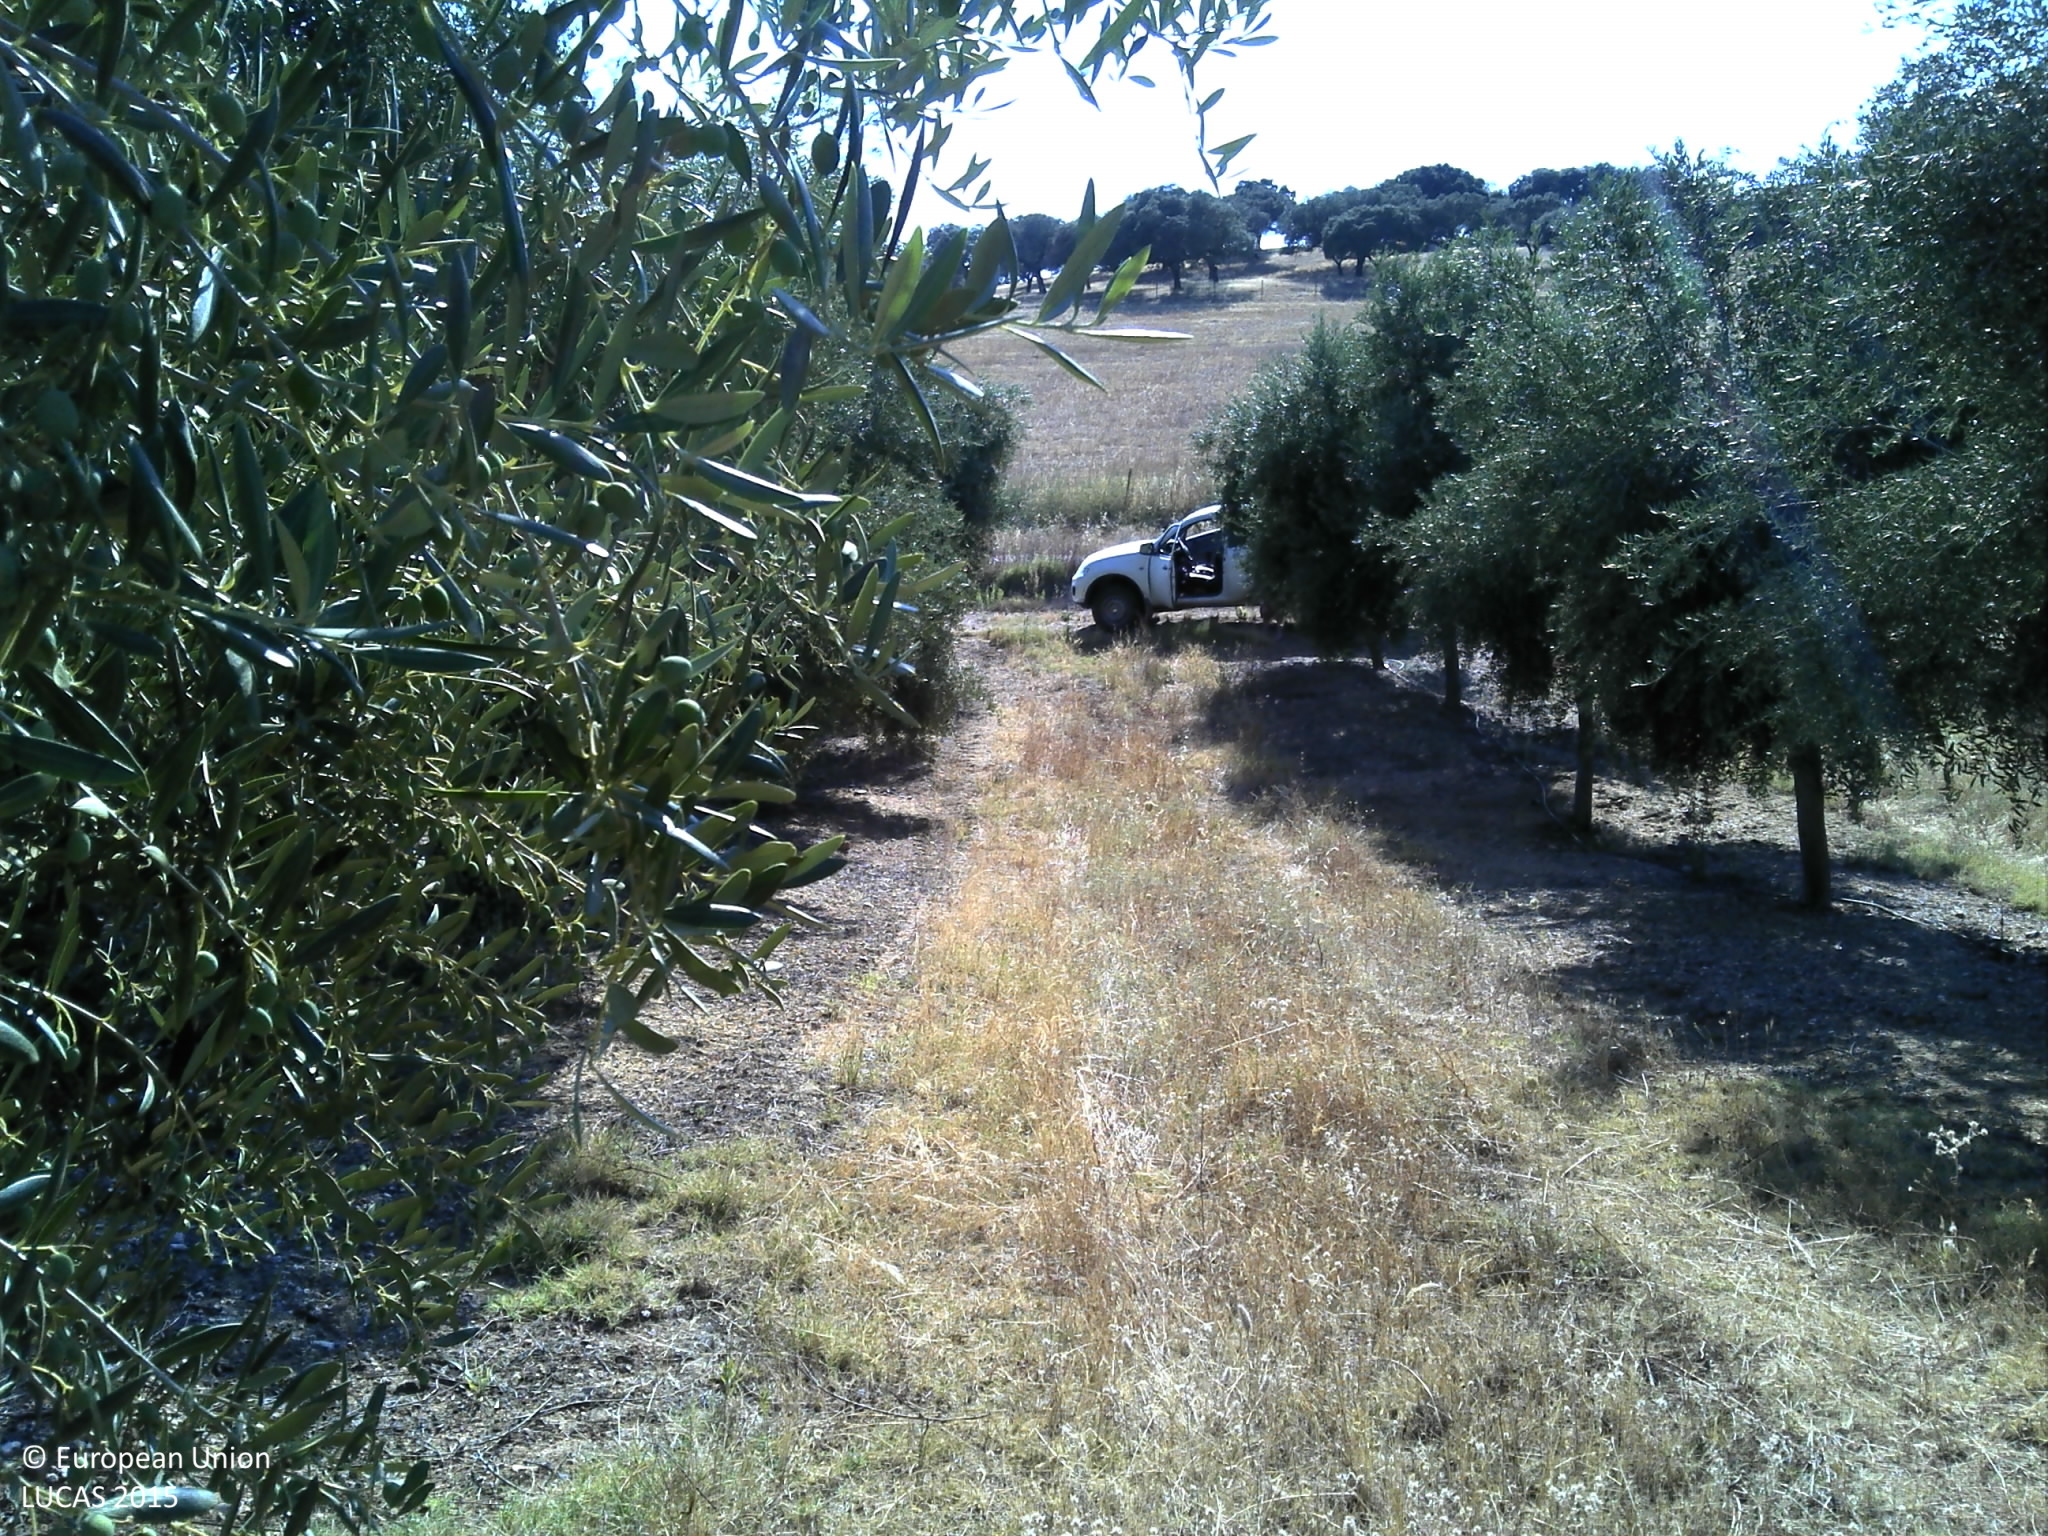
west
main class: Cropland
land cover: Olive groves
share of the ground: 25 - 50 %
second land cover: Grassland without tree/shrub cover
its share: 25 - 50 %
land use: Agriculture (excluding fallow land and kitchen gardens)
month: June
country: PT
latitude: 38.0864
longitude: -7.6157
